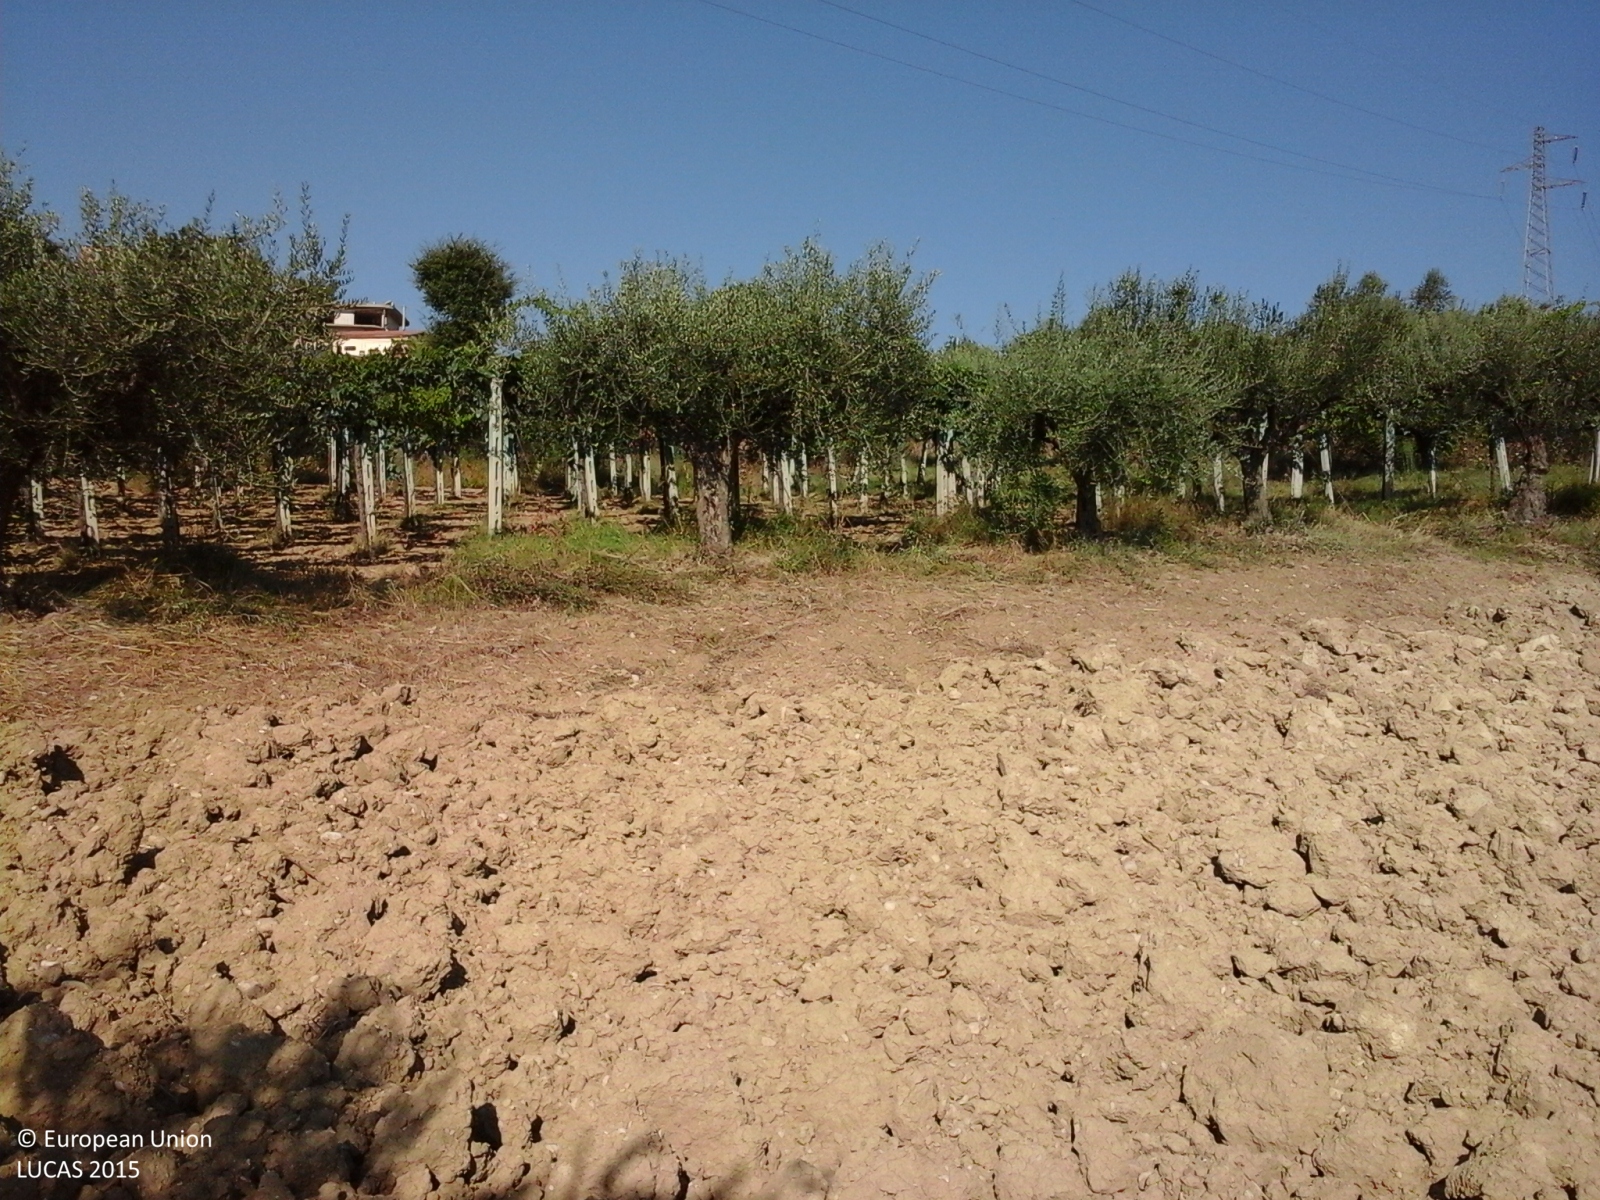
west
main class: Cropland
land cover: Olive groves
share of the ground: < 10 %
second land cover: Durum wheat
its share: > 75 %
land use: Agriculture (excluding fallow land and kitchen gardens)
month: August
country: IT
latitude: 42.5913
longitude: 14.0463
